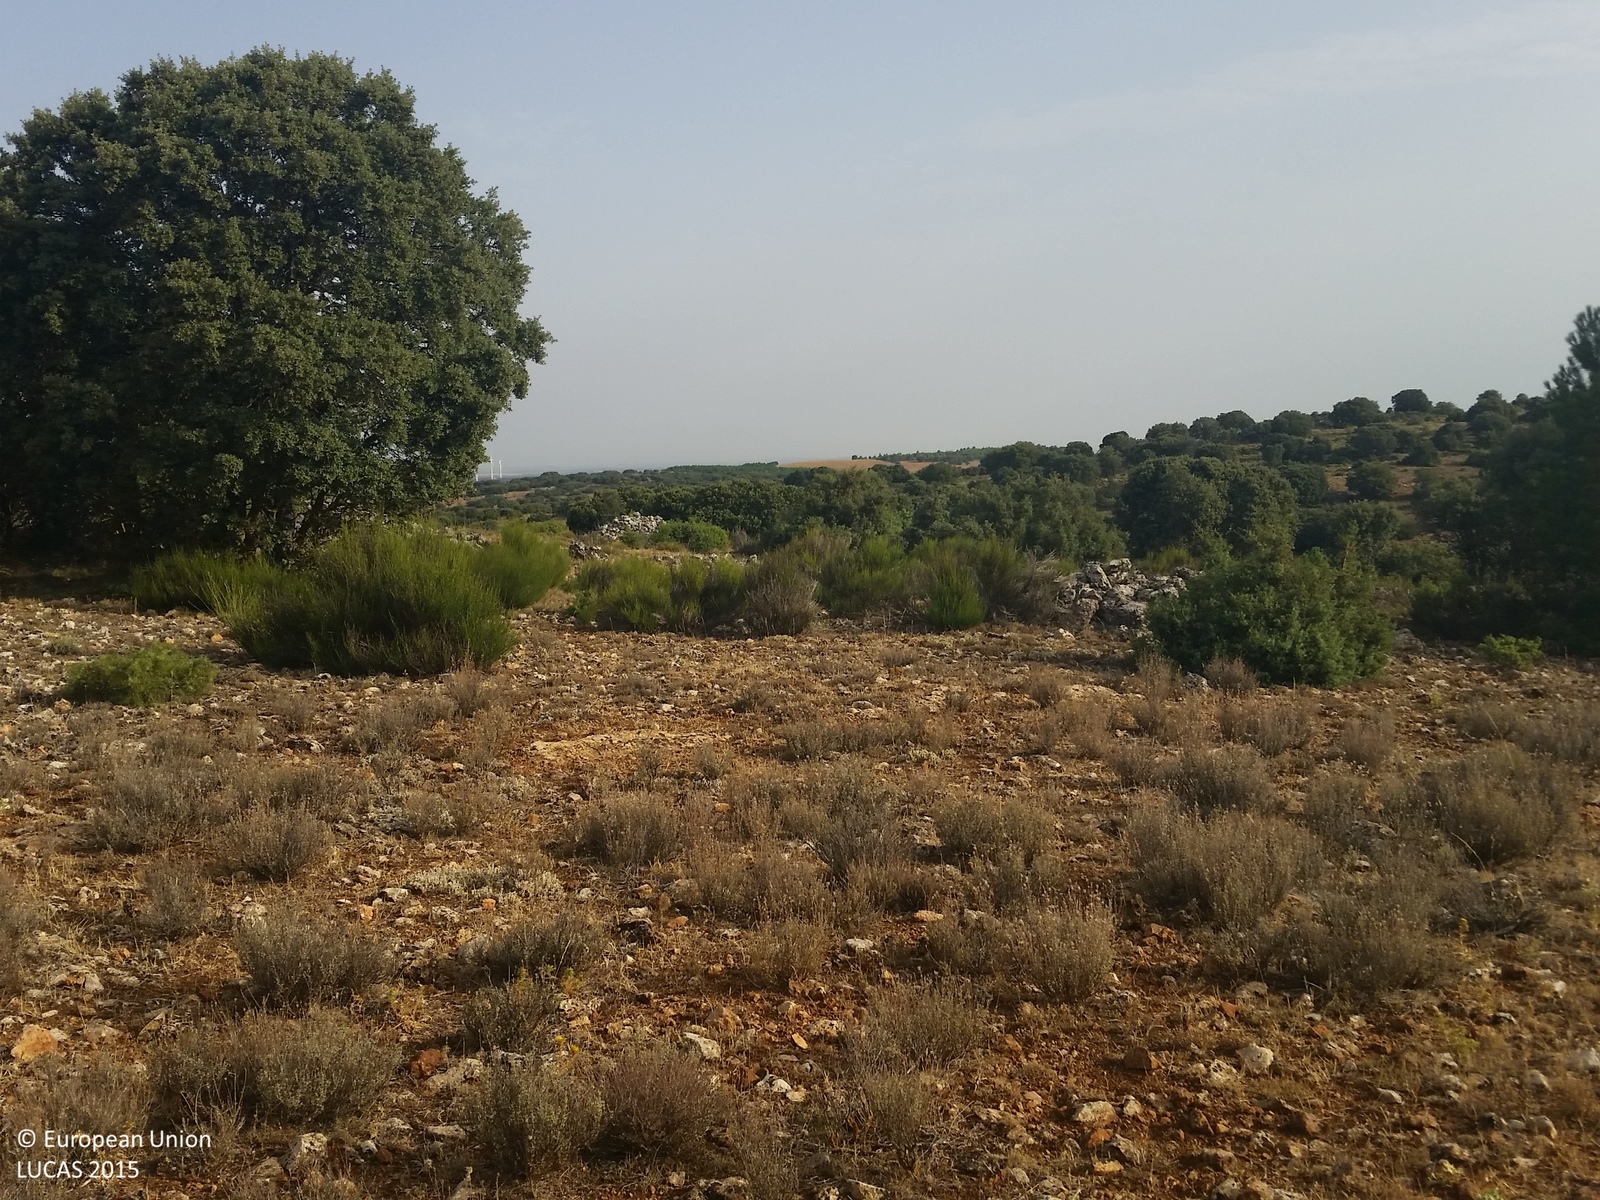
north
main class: Woodland
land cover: Broadleaved woodland
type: broadleaved evergreen forest
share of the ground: 25 - 50 %
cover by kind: shrubs 40 %, consolidated bare surface 30 %, broadleaved forest trees 25 %, herbaceous plants 5 %
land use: Semi-natural and natural areas not in use
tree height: < 5 m
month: August
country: ES
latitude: 38.6514
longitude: -2.4216
